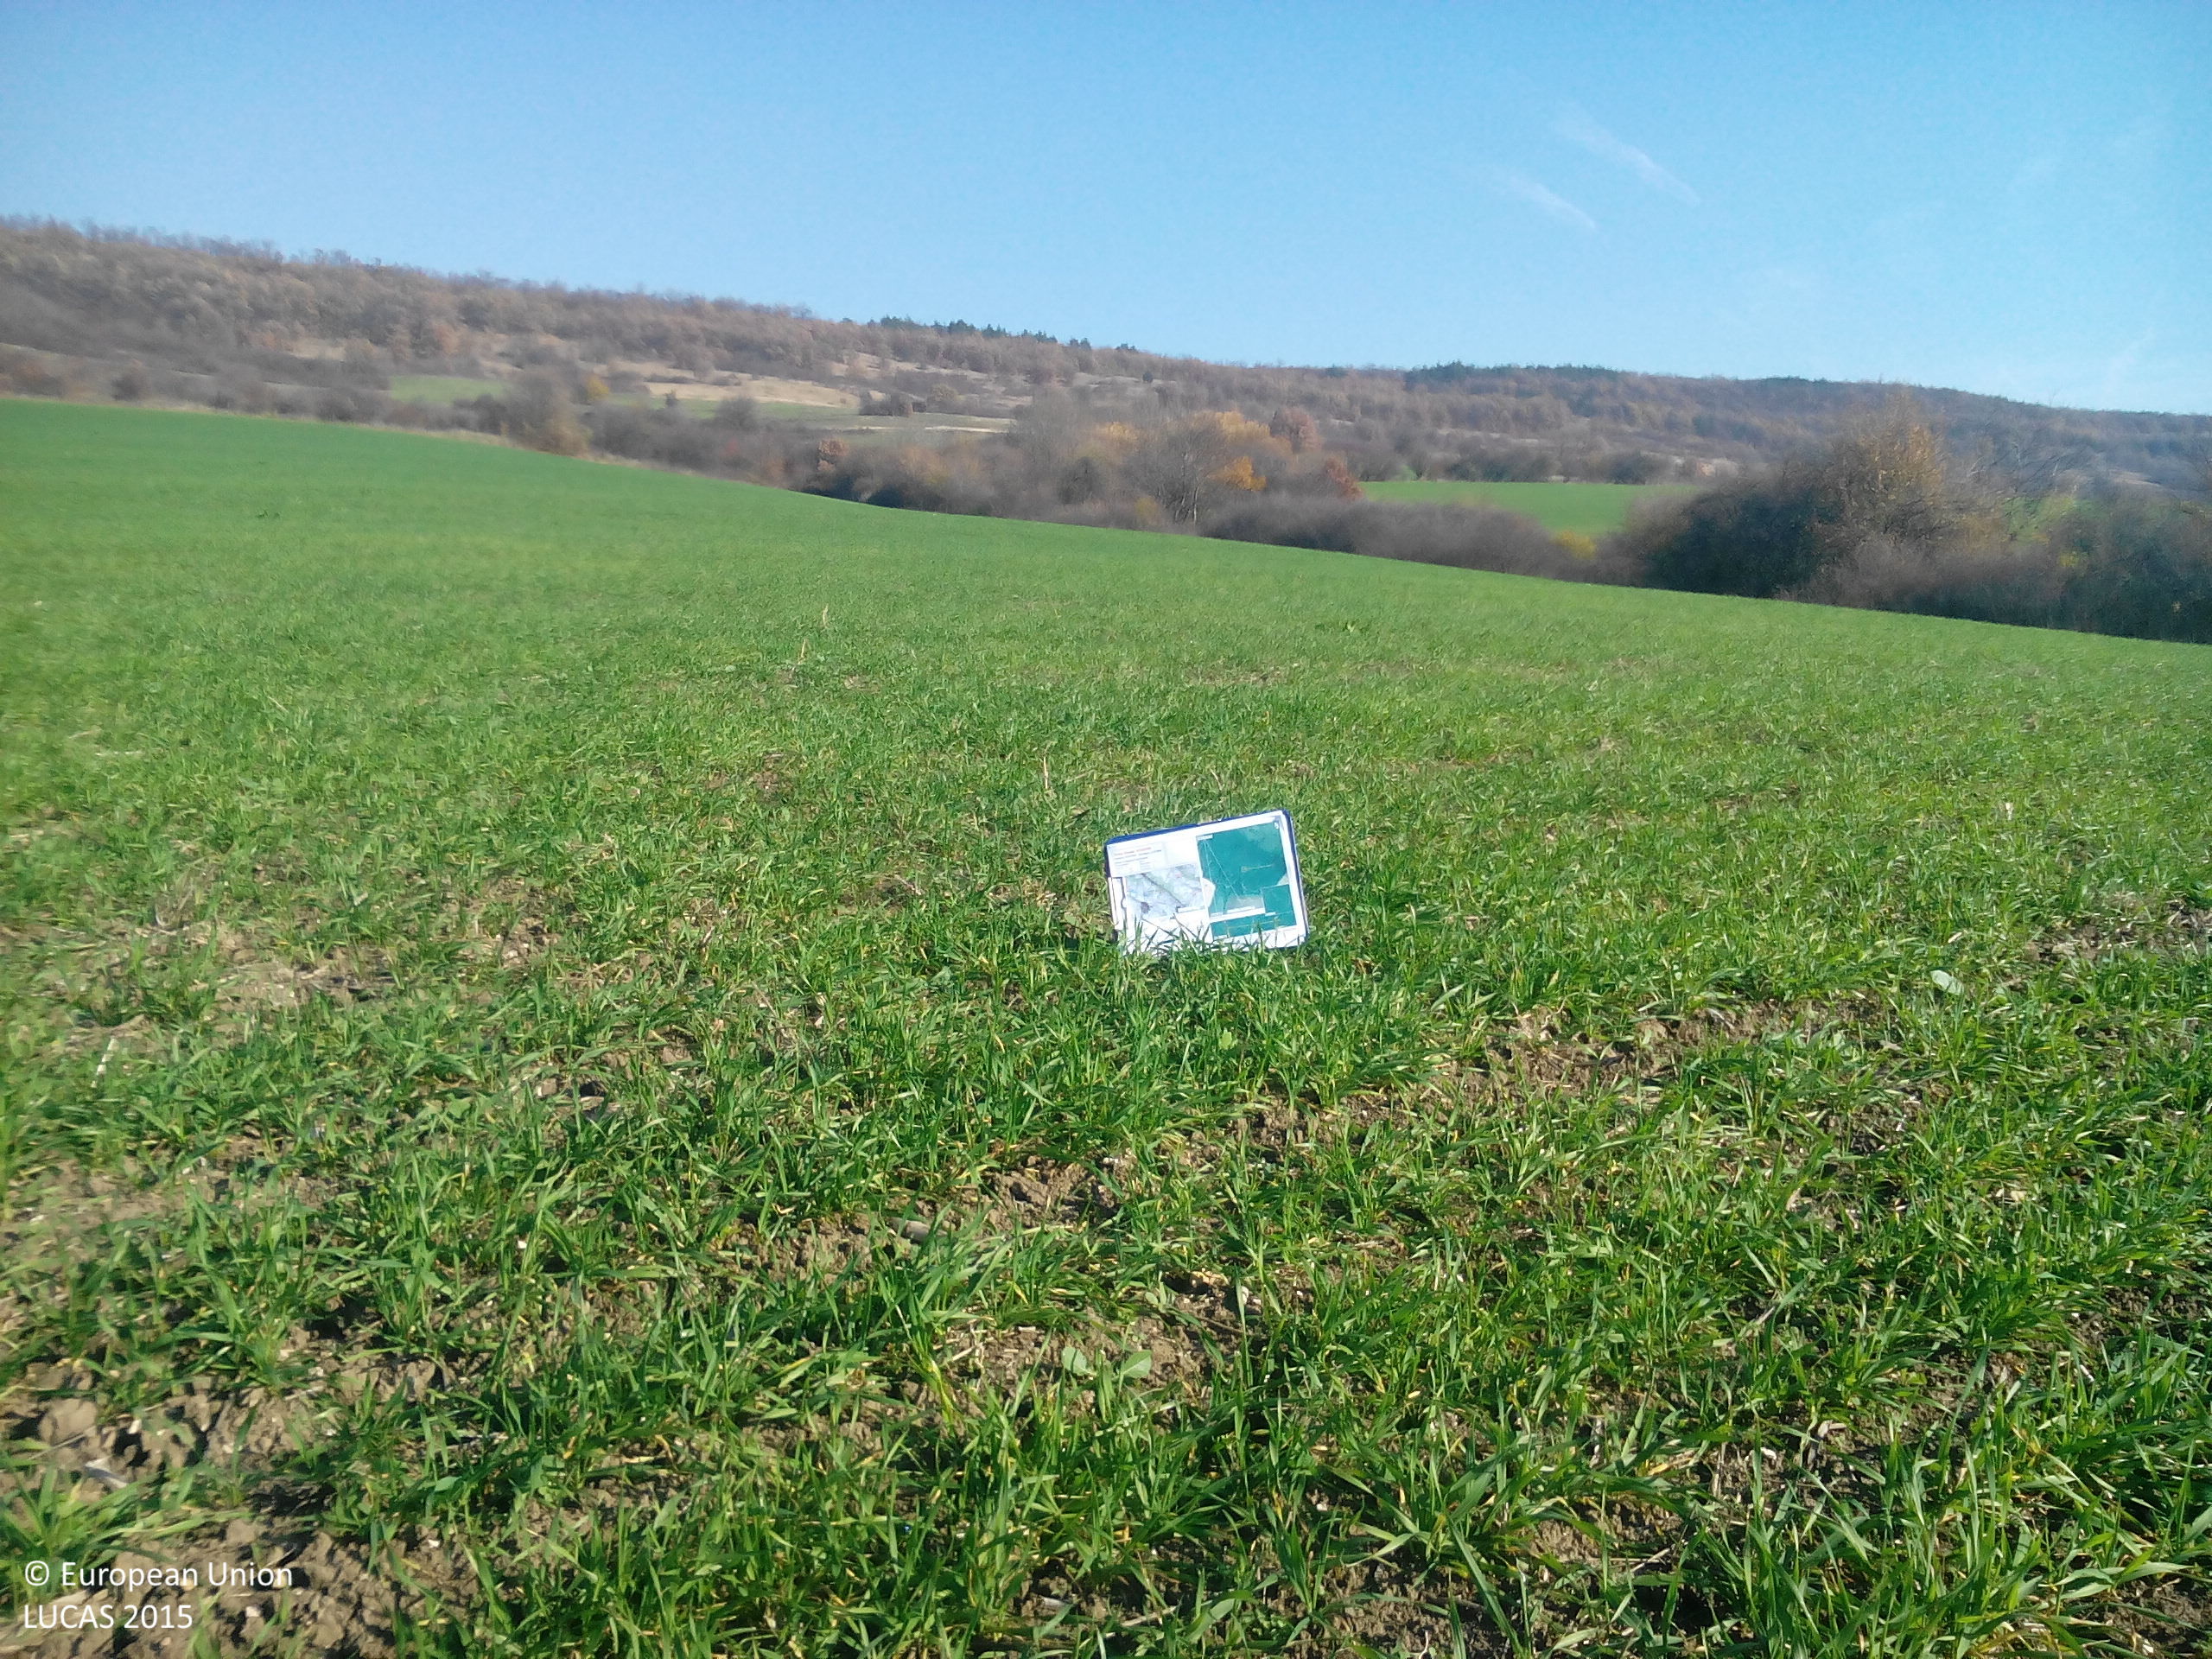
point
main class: Cropland
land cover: Common wheat
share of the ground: 50 - 75 %
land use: Agriculture (excluding fallow land and kitchen gardens)
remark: Harvested field
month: November
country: BG
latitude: 43.3111
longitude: 23.8195
